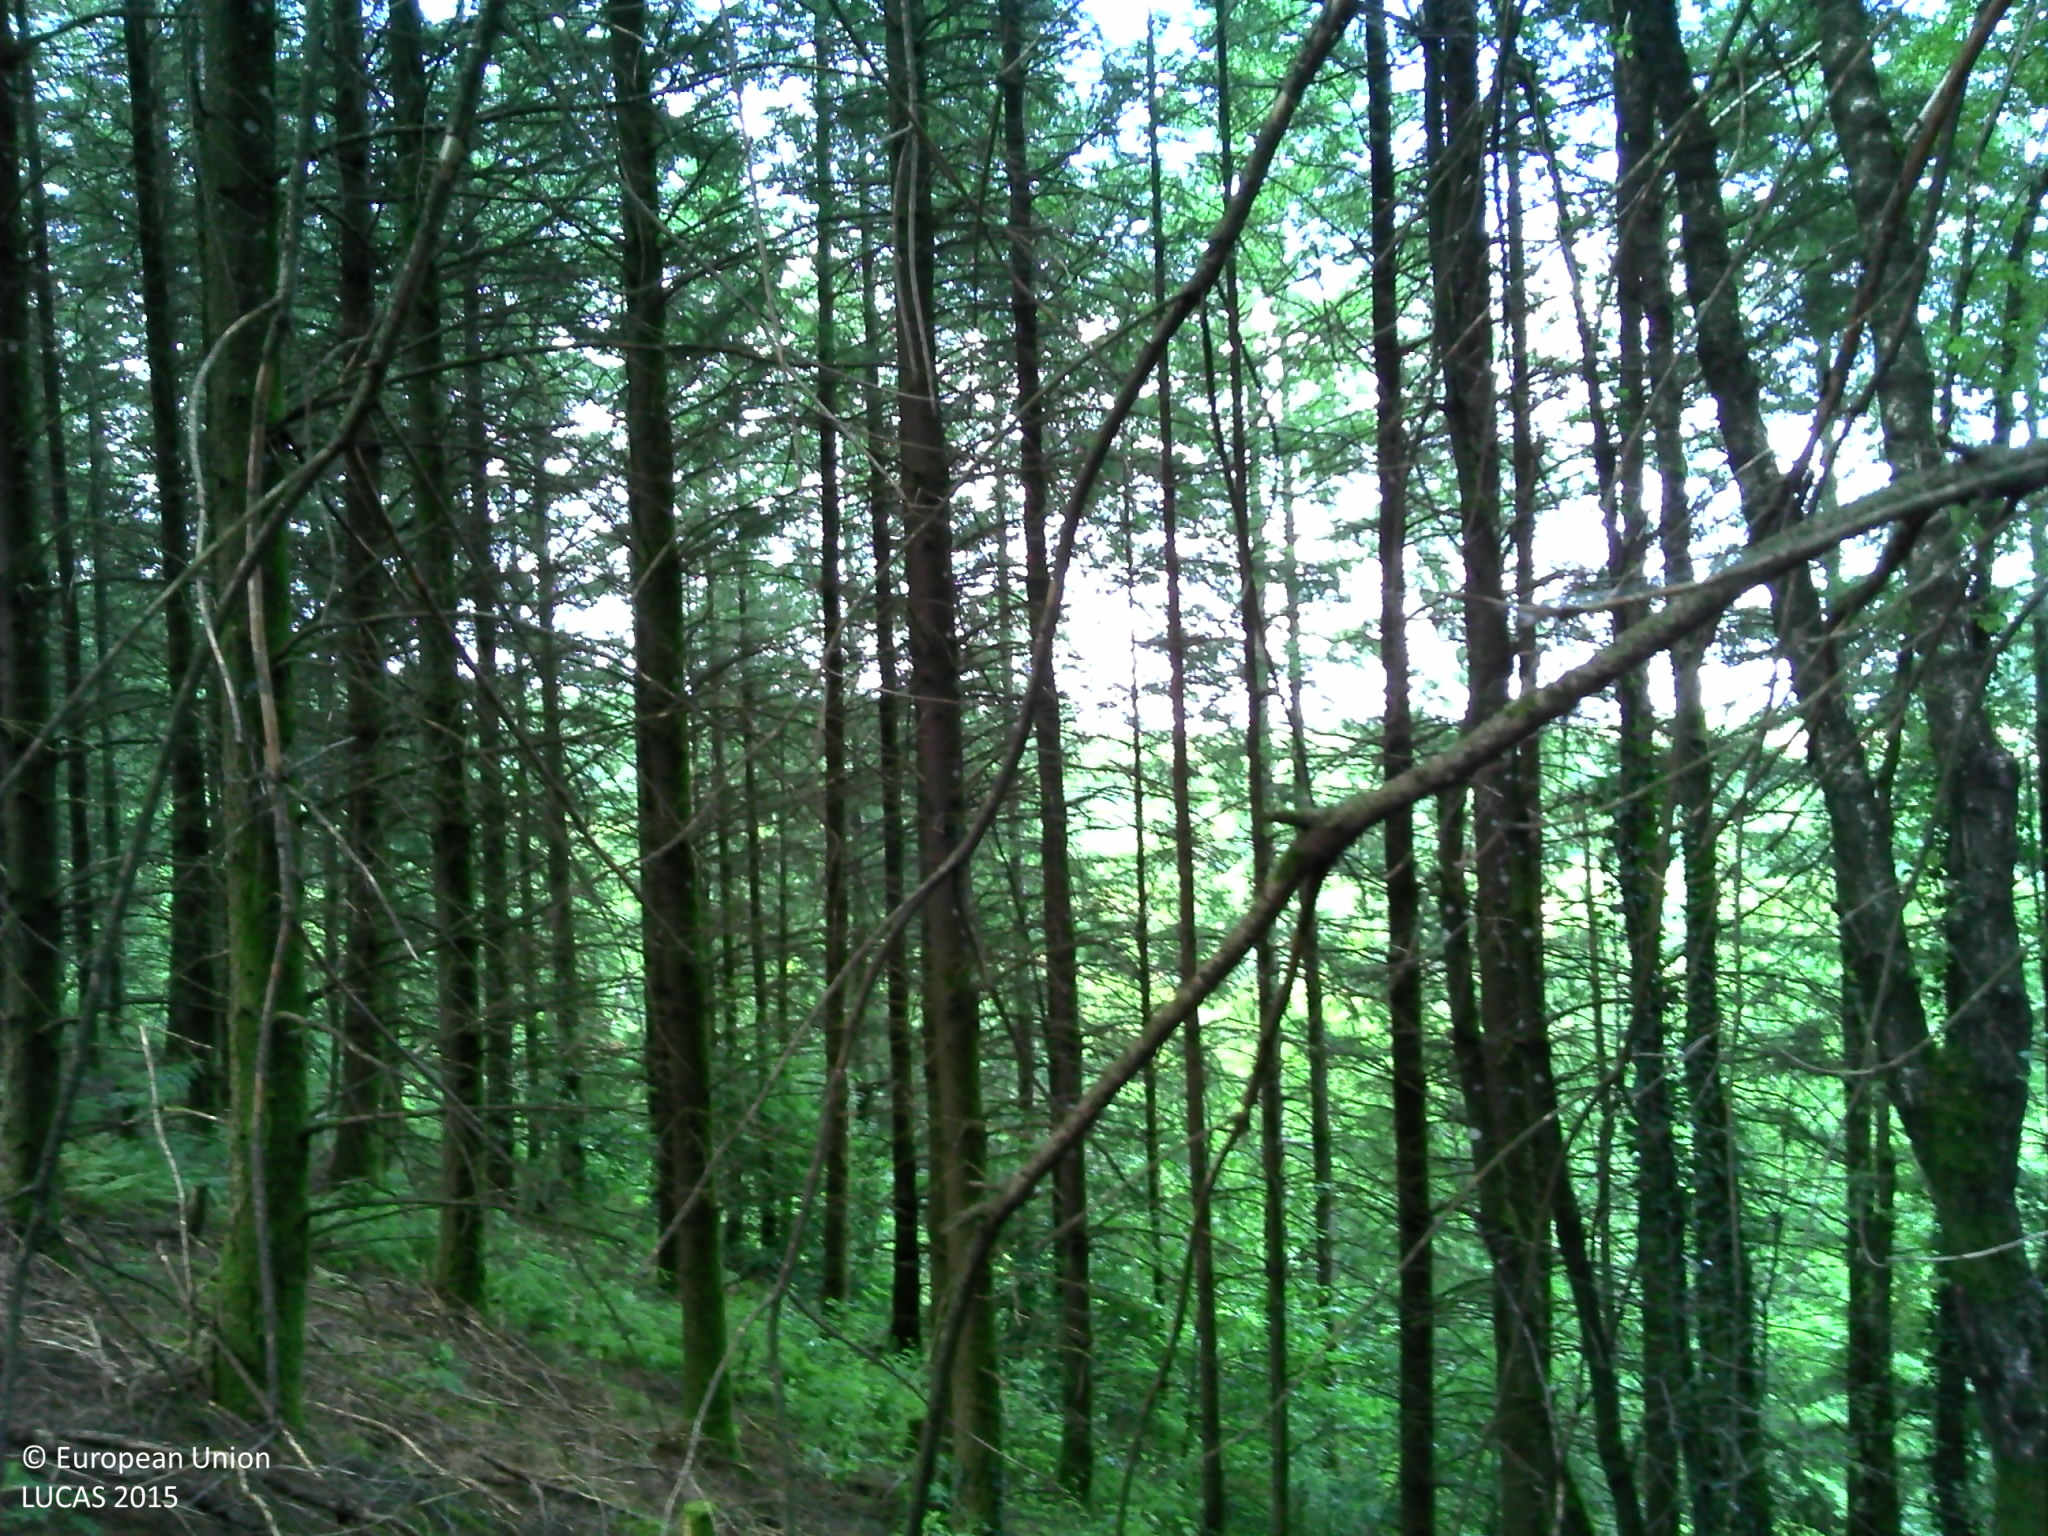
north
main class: Woodland
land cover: Spruce dominated coniferous woodland
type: exotic forest
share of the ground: > 75 %
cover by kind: coniferous forest trees 70 %, lichens and mosses 20 %, herbaceous plants 10 %
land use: Forestry
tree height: > 5 m
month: July
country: FR
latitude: 45.6514
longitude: 1.7433
